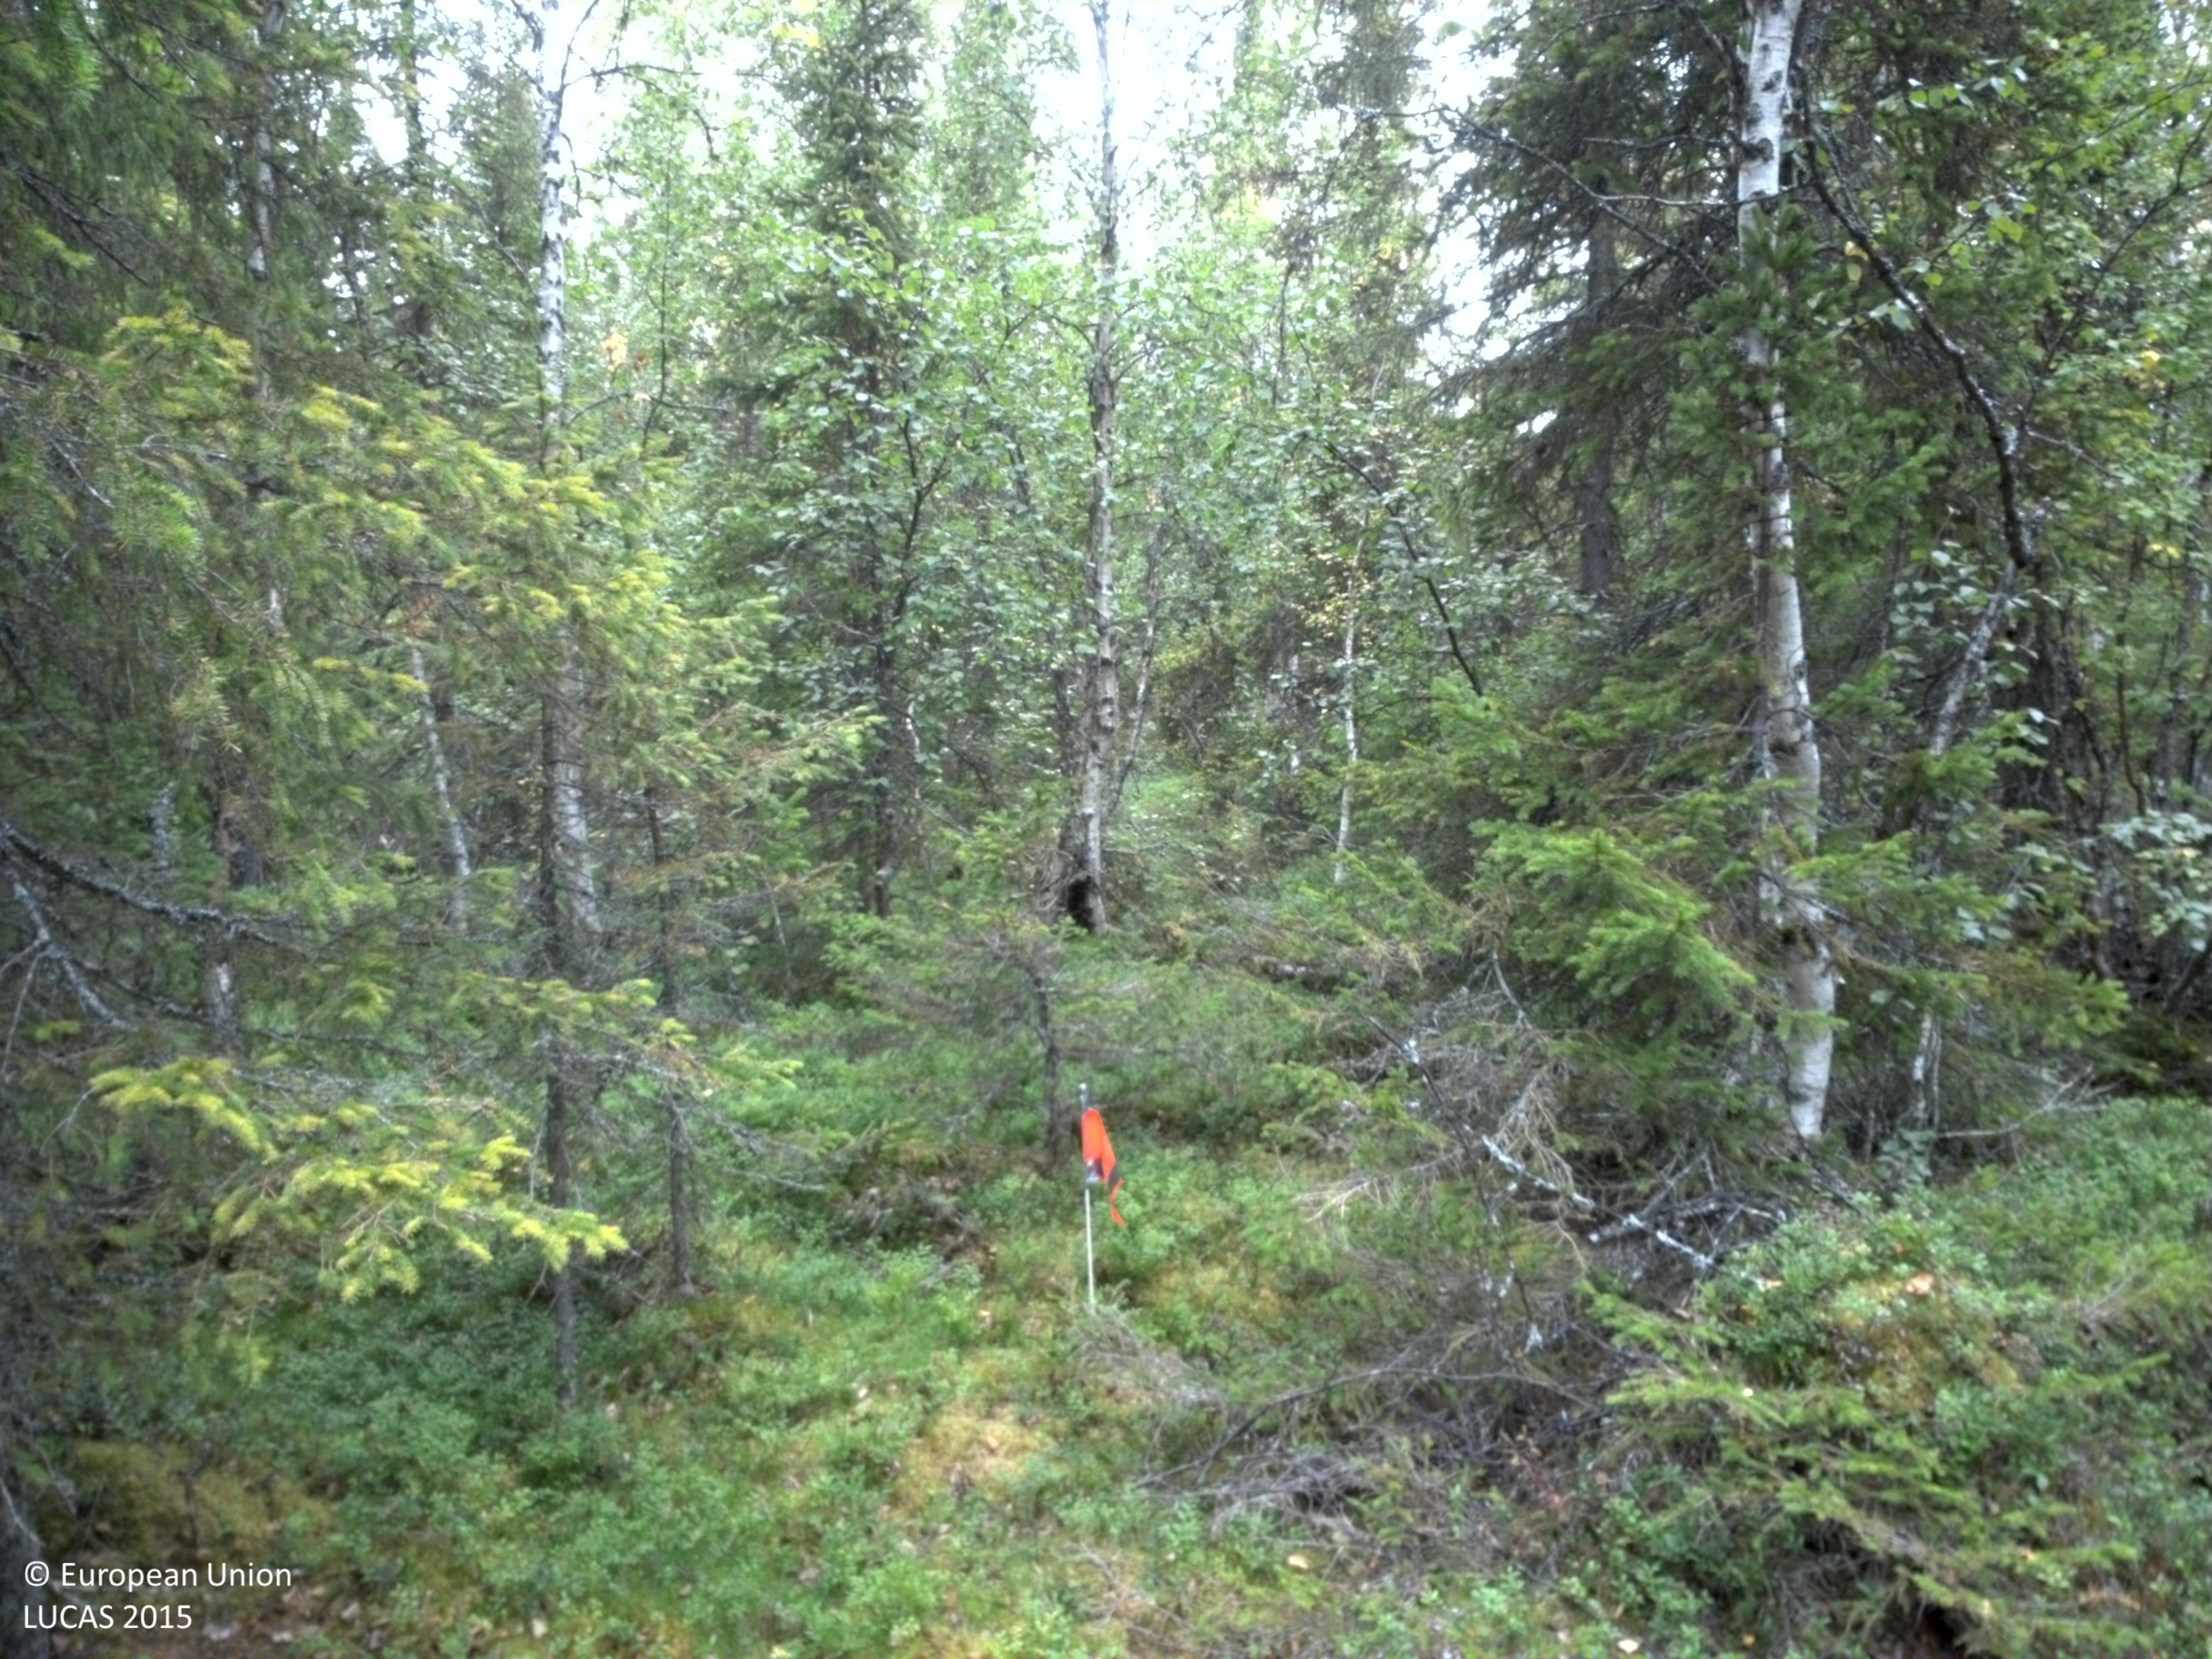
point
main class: Woodland
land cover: Spruce dominated mixed woodland
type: boreal forest
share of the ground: 50 - 75 %
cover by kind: shrubs 30 %, coniferous forest trees 25 %, broadleaved forest trees 25 %, lichens and mosses 20 %
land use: Forestry
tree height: > 5 m
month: September
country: SE
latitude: 65.3671
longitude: 16.1344
